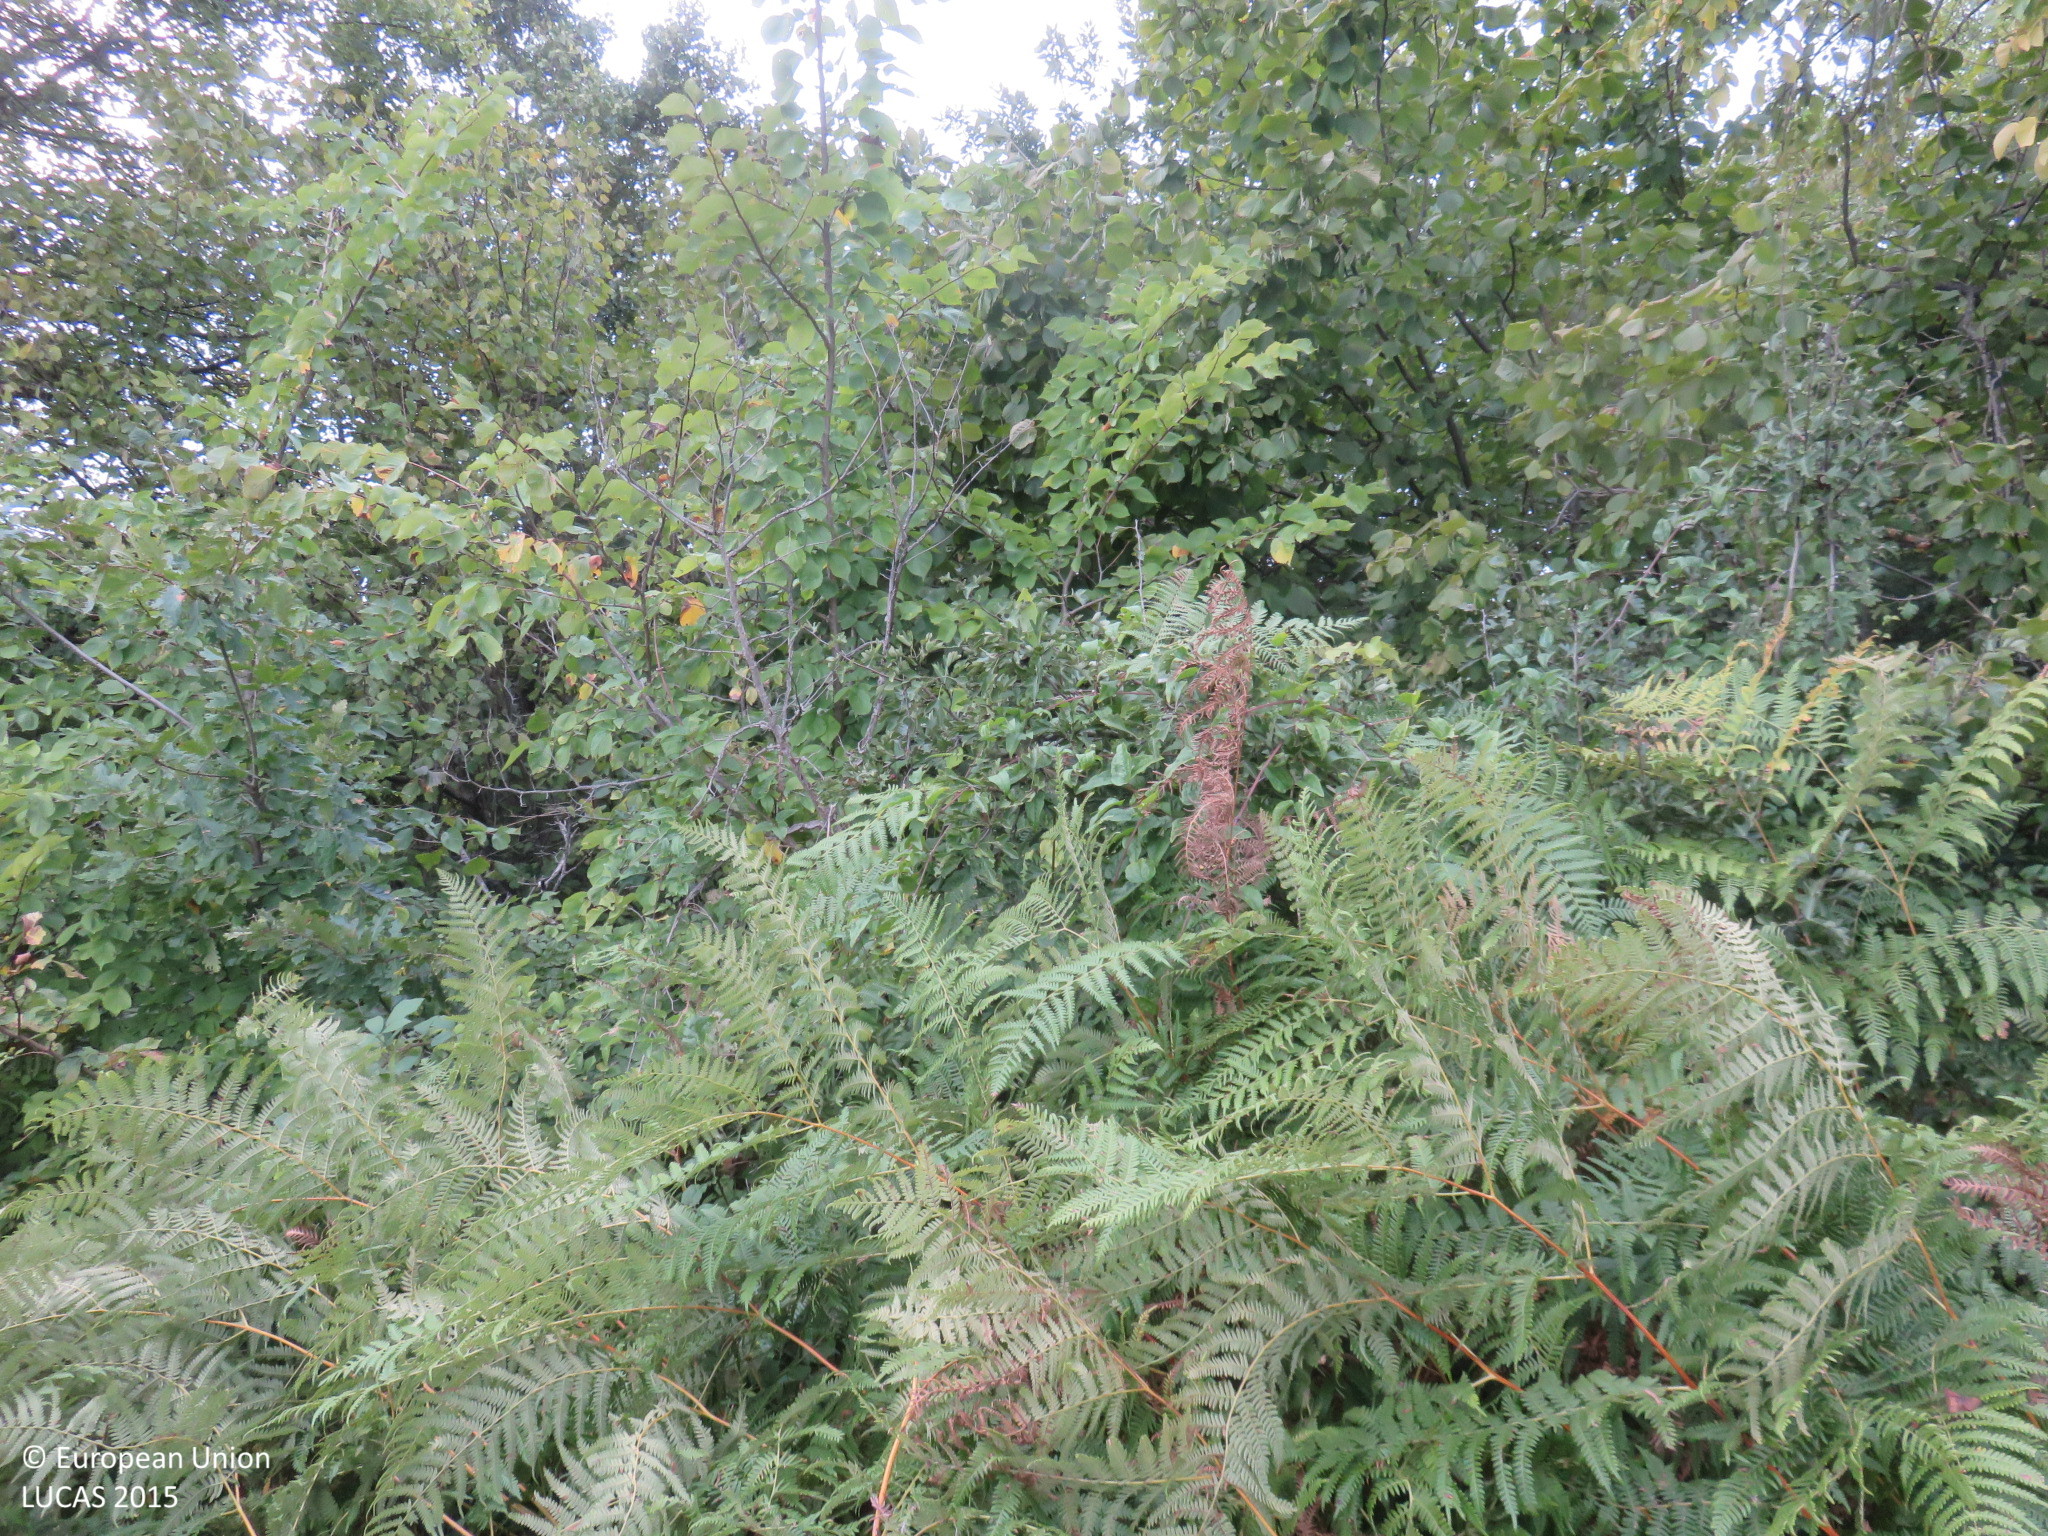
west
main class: Shrubland
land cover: Shrubland with sparse tree cover
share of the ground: > 75 %
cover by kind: shrubs 90 %, broadleaved forest trees 5 %, herbaceous plants 5 %
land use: Semi-natural and natural areas not in use
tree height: < 5 m
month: October
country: BG
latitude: 43.0540
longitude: 24.8581
